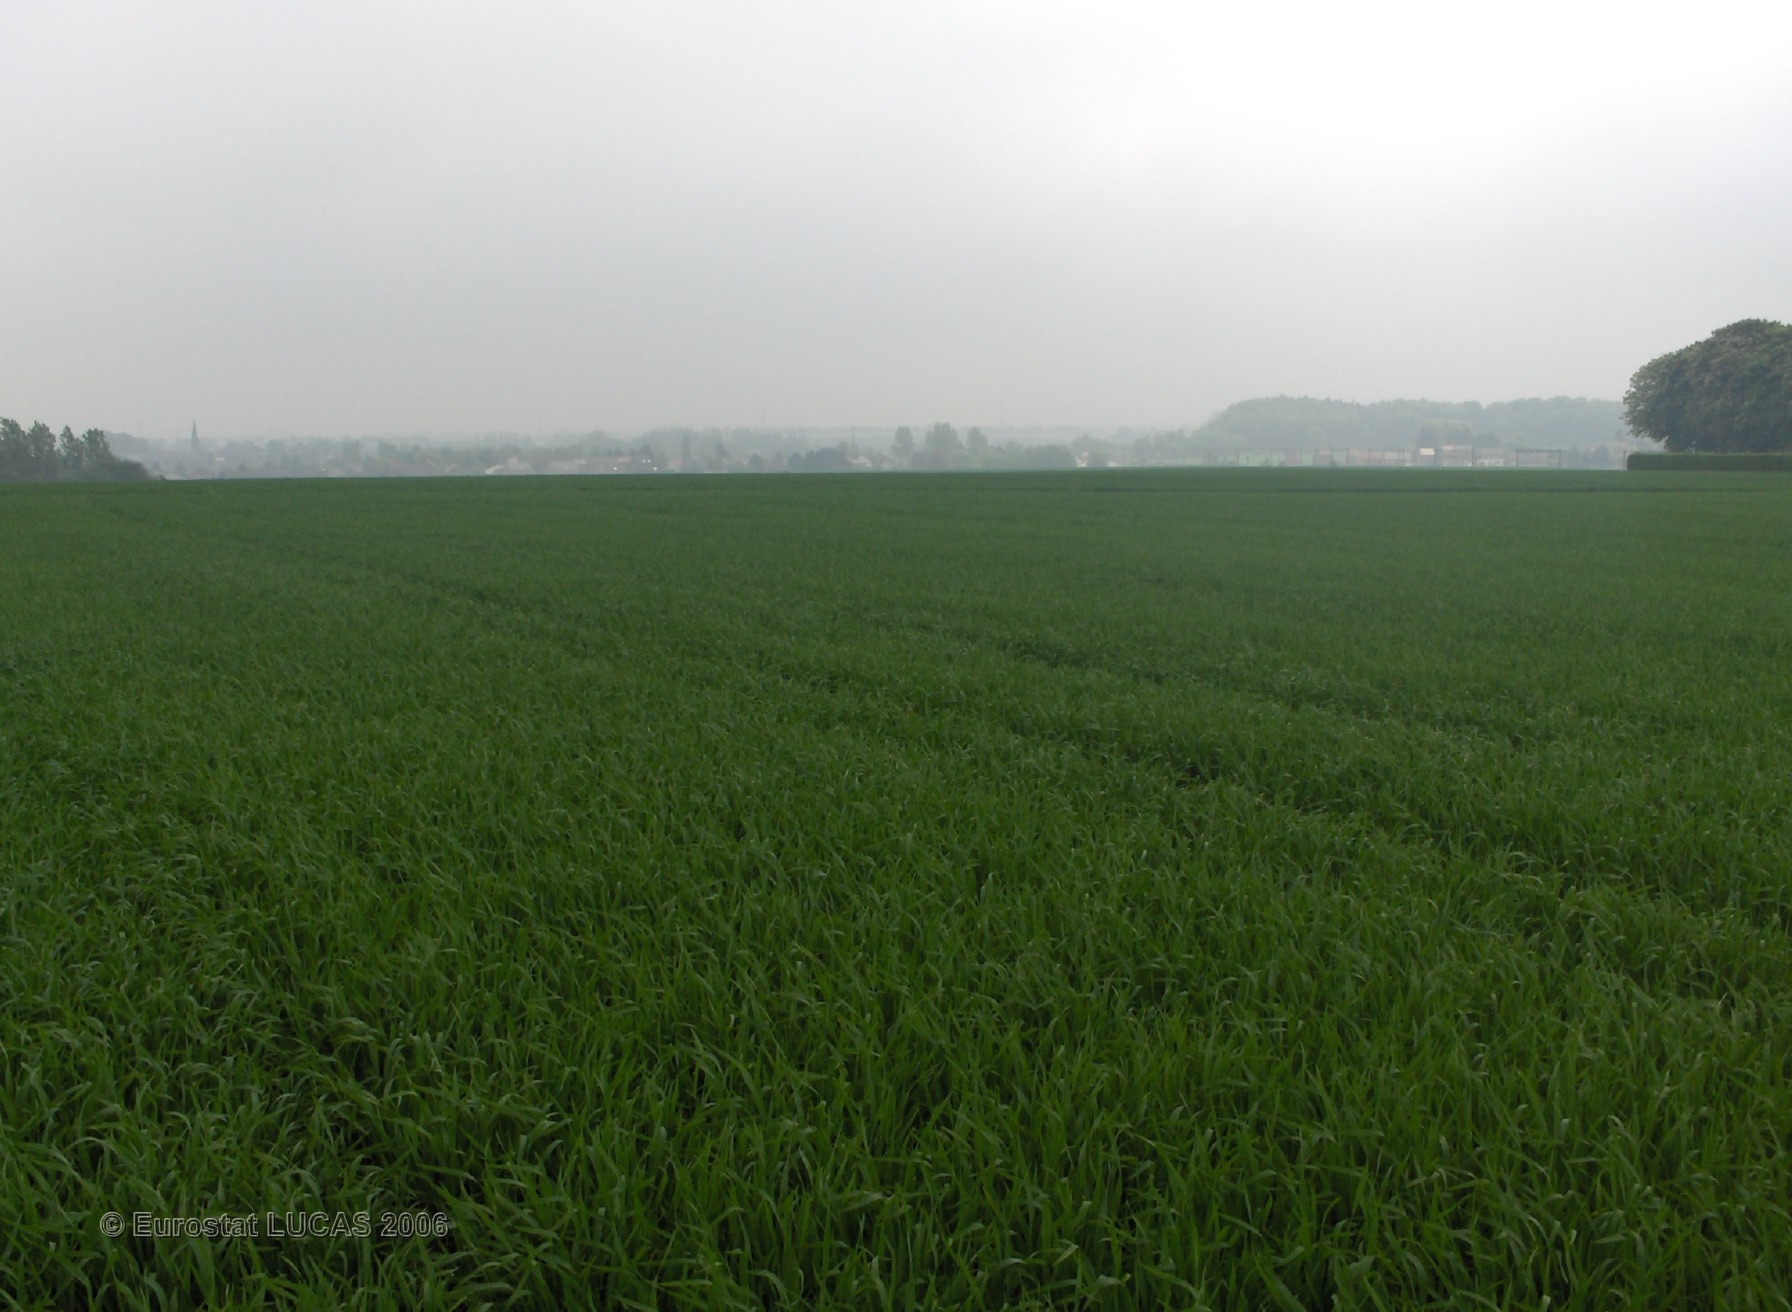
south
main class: Cropland
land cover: Common wheat
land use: Agriculture (excluding fallow land and kitchen gardens)
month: May
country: BE
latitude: 50.5233
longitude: 4.5655
